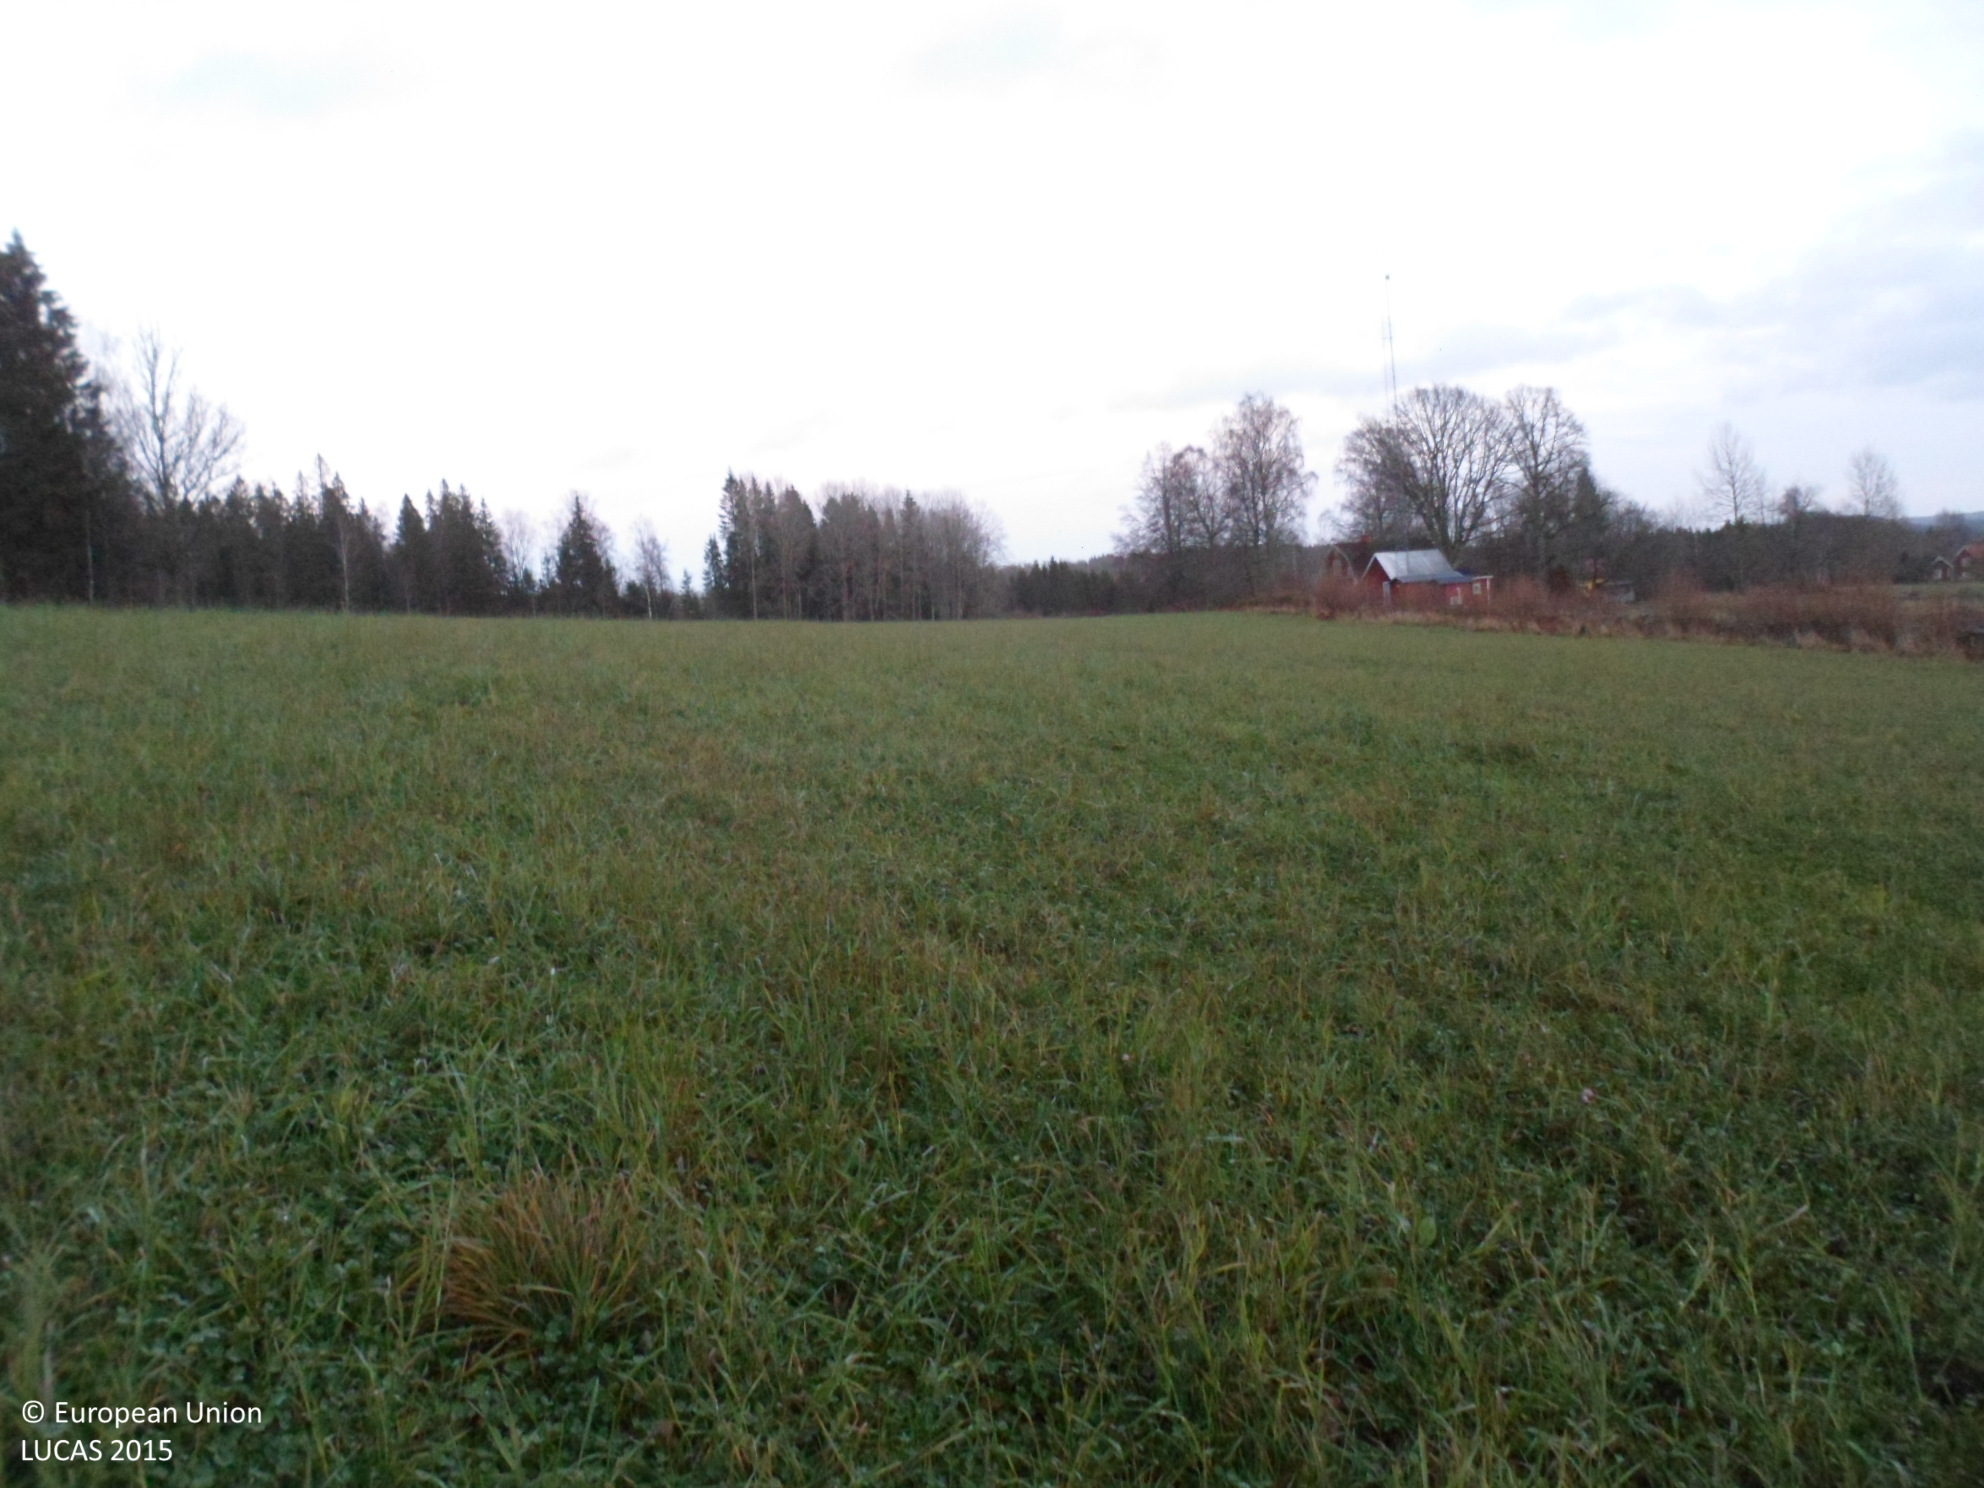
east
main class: Grassland
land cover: Grassland without tree/shrub cover
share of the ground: > 75 %
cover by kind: herbaceous plants 100 %
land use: Agriculture (excluding fallow land and kitchen gardens)
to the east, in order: Grassland without tree/shrub cover; Ditches and canals; Paved roads, cycling and walking lanes; Ditches and canals; Grassland without tree/shrub cover; Dry stone walls; Broadleaved woodland; Spruce dominated mixed woodland
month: November
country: SE
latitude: 57.5949
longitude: 15.2328
